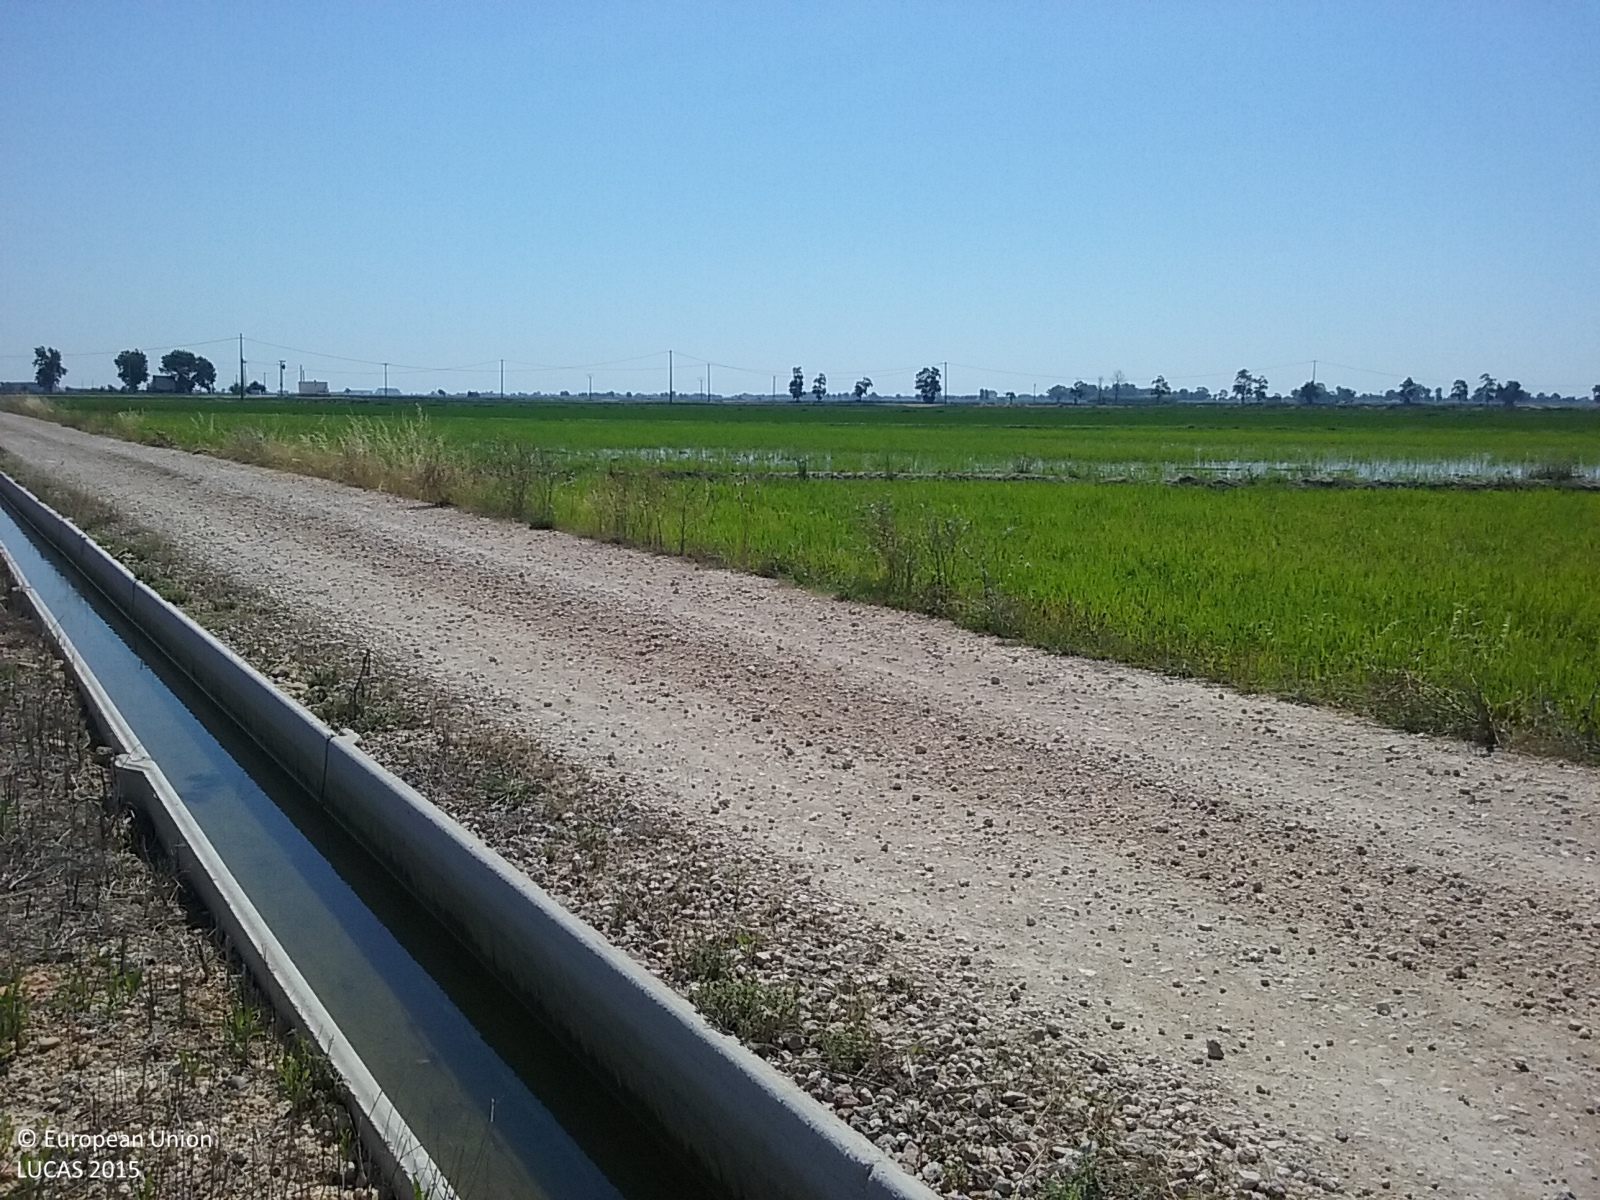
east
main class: Cropland
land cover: Rice
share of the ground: 50 - 75 %
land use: Agriculture (excluding fallow land and kitchen gardens)
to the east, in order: Rice; Ditches and canals; Tracks; Rice; Other structural elements; Rice; Other structural elements; Rice
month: June
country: ES
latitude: 40.7279
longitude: 0.6296
